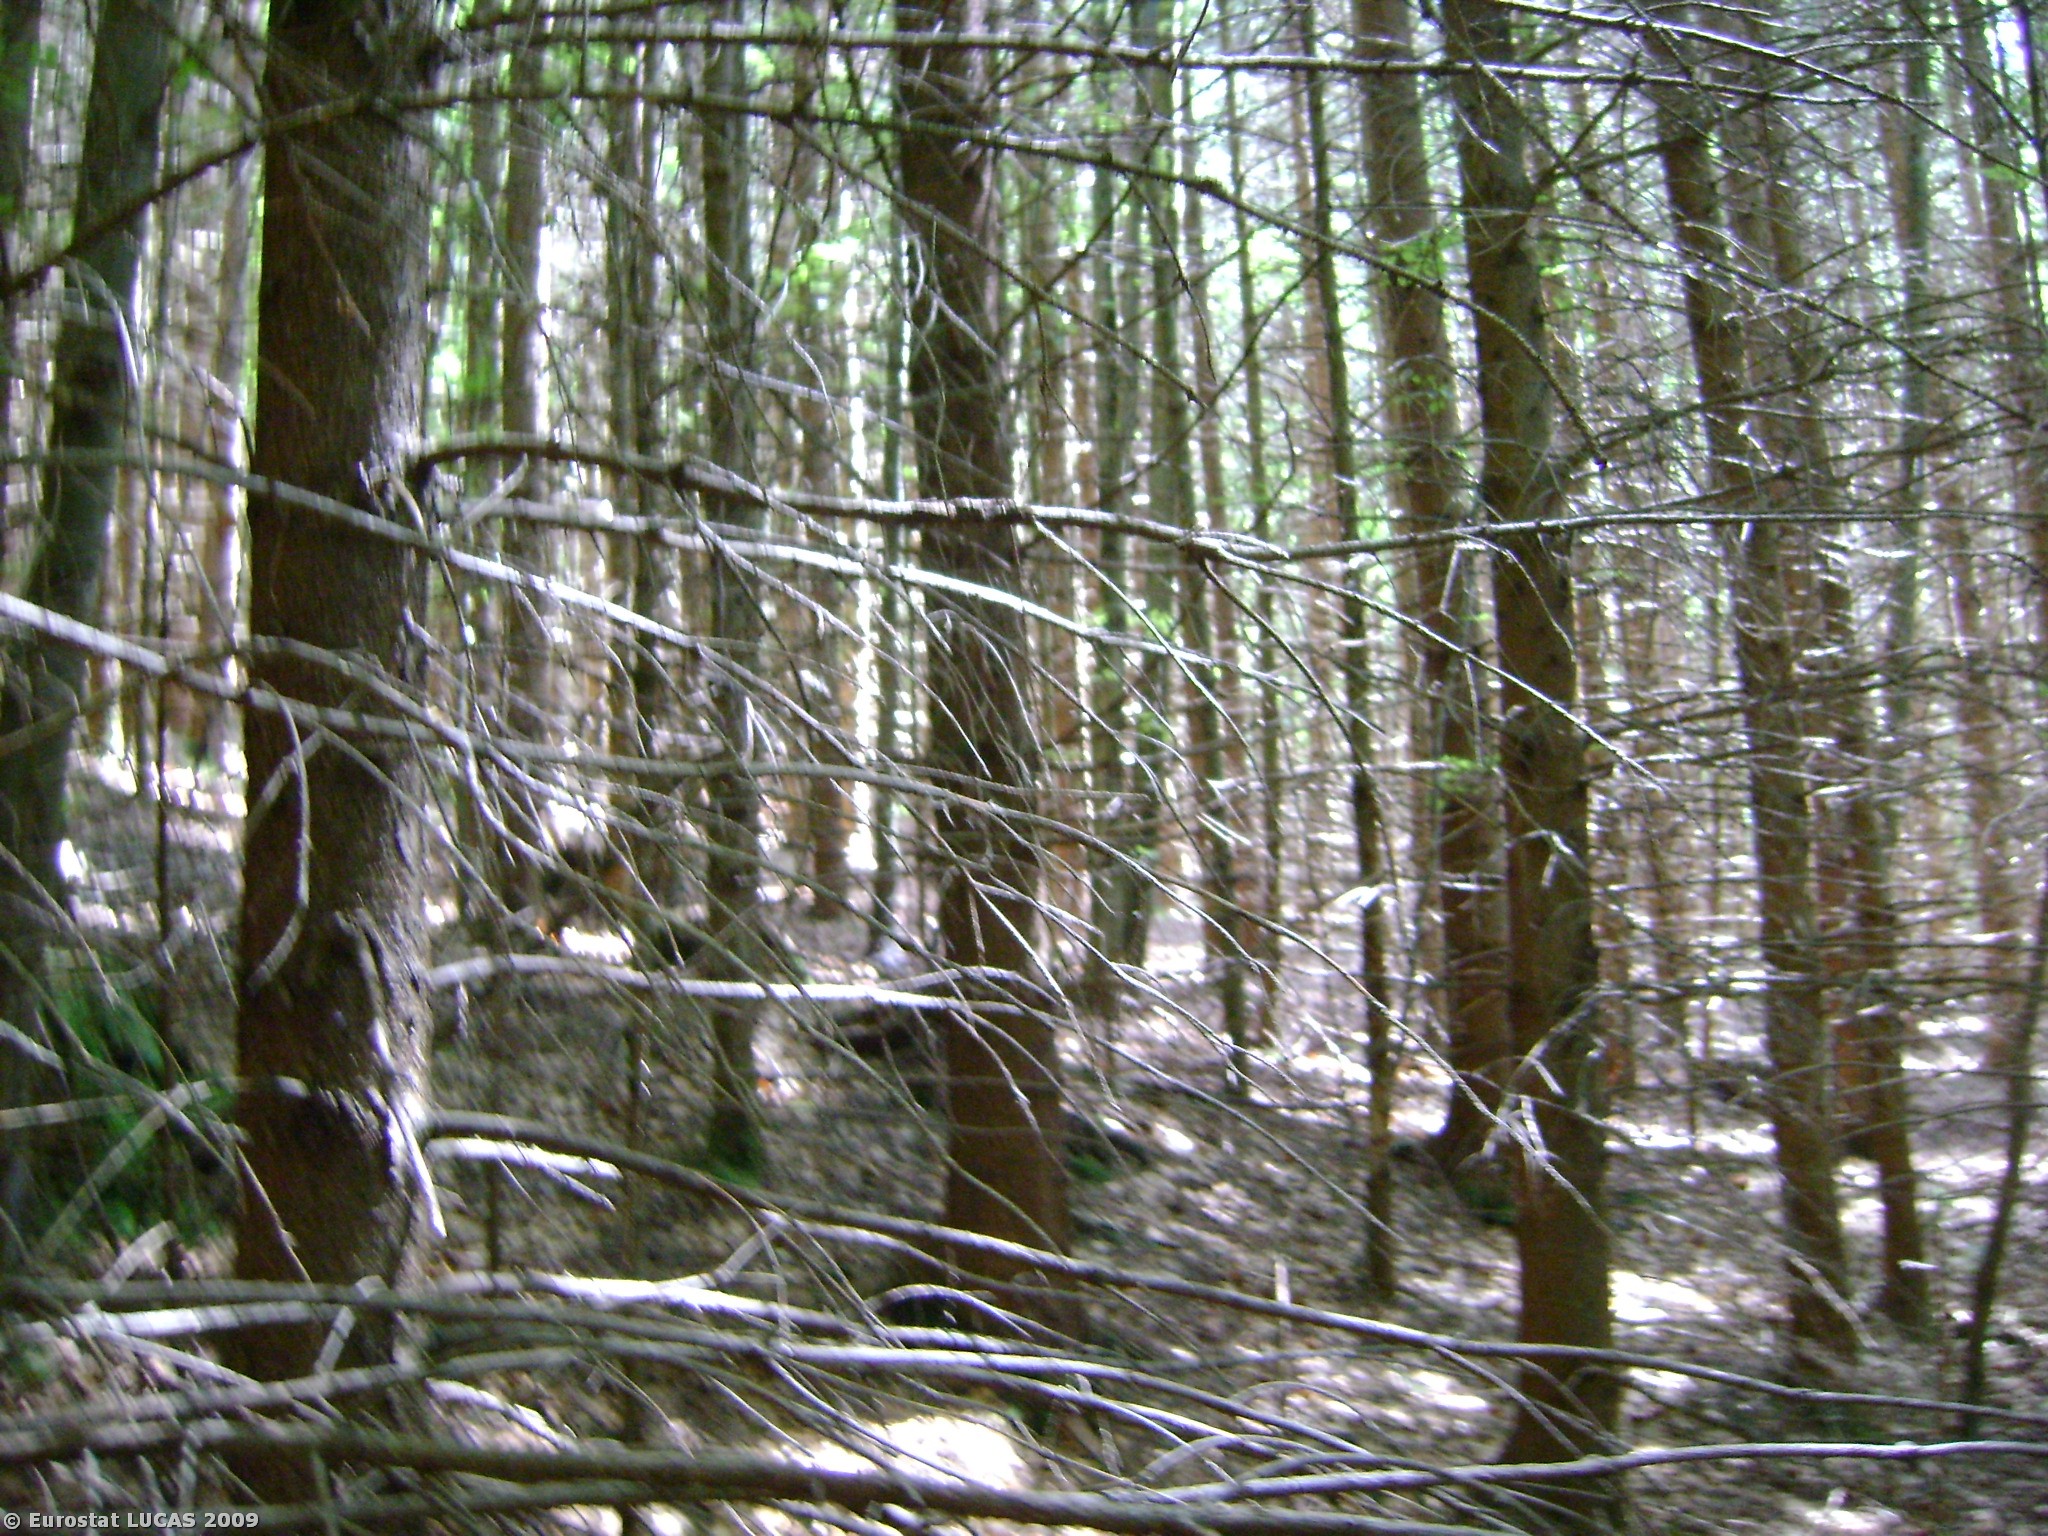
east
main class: Woodland
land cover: Coniferous woodland
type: boreal forest
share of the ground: > 75 %
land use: Forestry
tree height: > 5 m
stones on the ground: < 10 %
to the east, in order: Coniferous woodland; Mixed woodland; Ditches and canals; Mixed woodland; Paved roads, cycling and walking lanes; Mixed woodland; Coniferous woodland
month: May
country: AT
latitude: 47.9235
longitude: 13.2509
